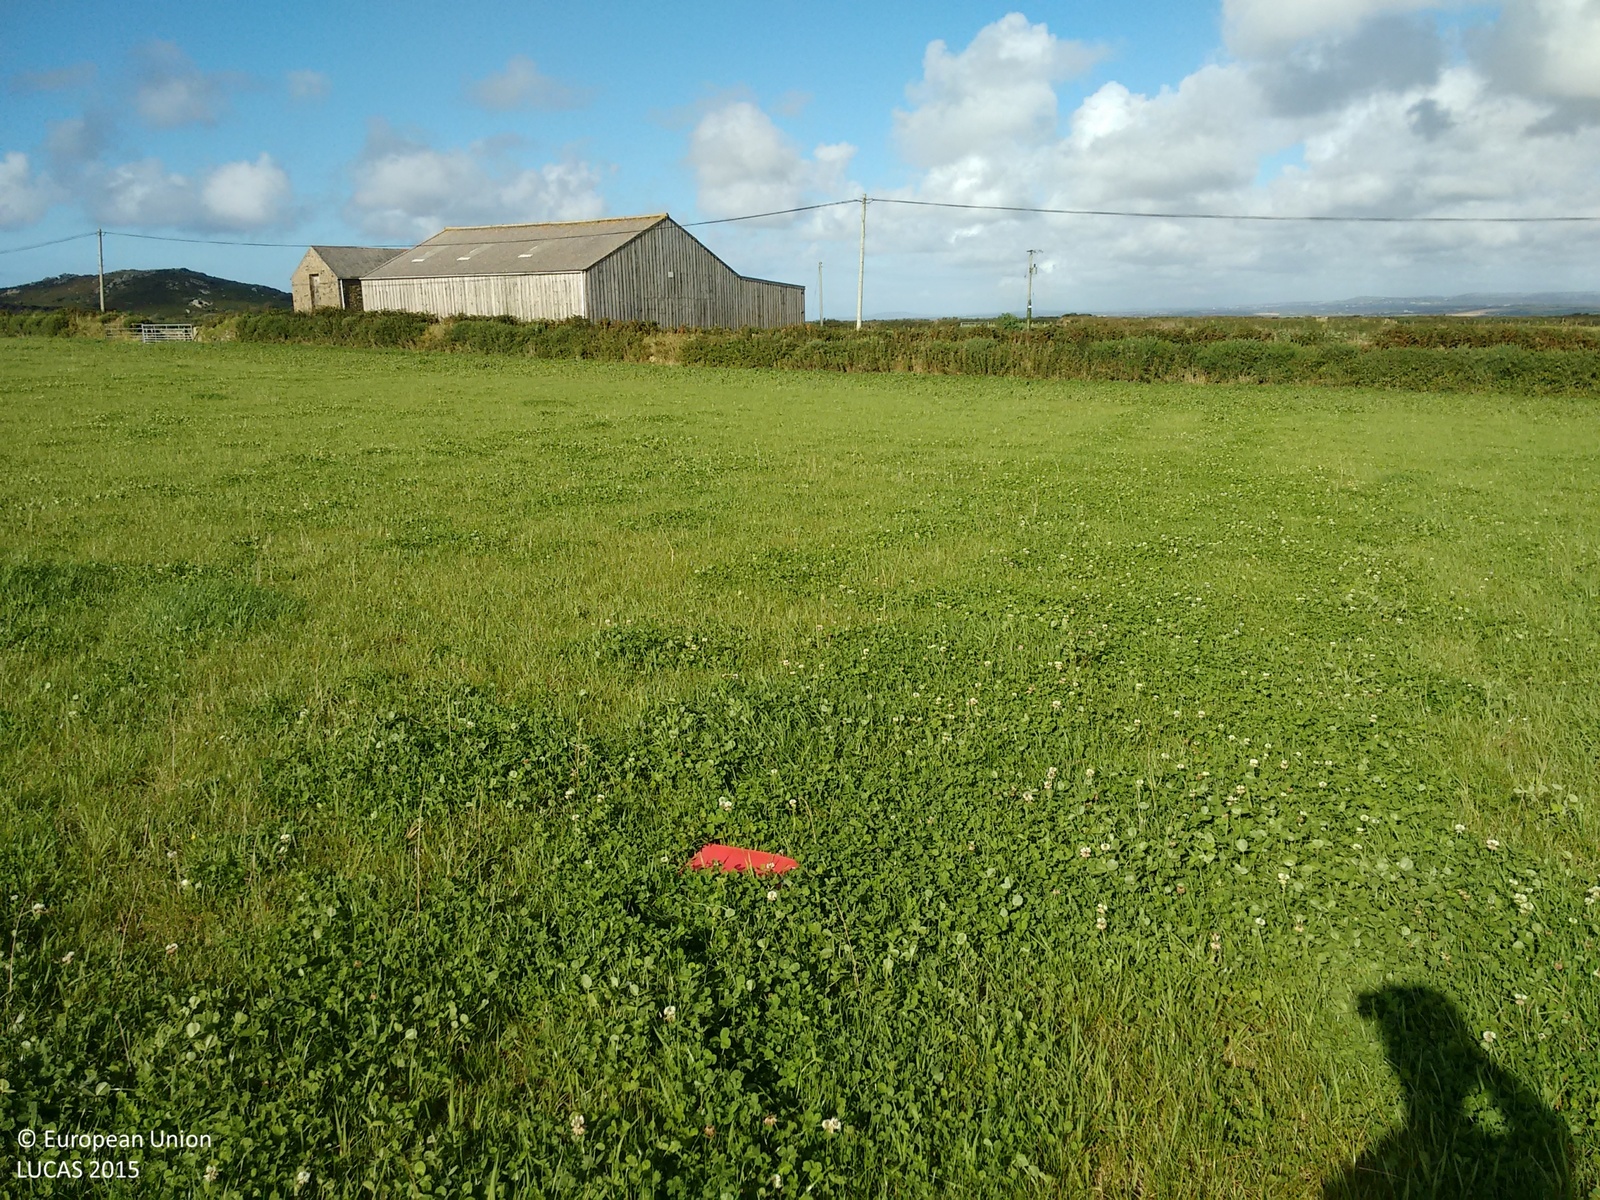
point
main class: Cropland
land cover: Clovers
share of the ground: > 75 %
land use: Agriculture (excluding fallow land and kitchen gardens)
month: August
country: GB
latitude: 50.1619
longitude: -5.4834
